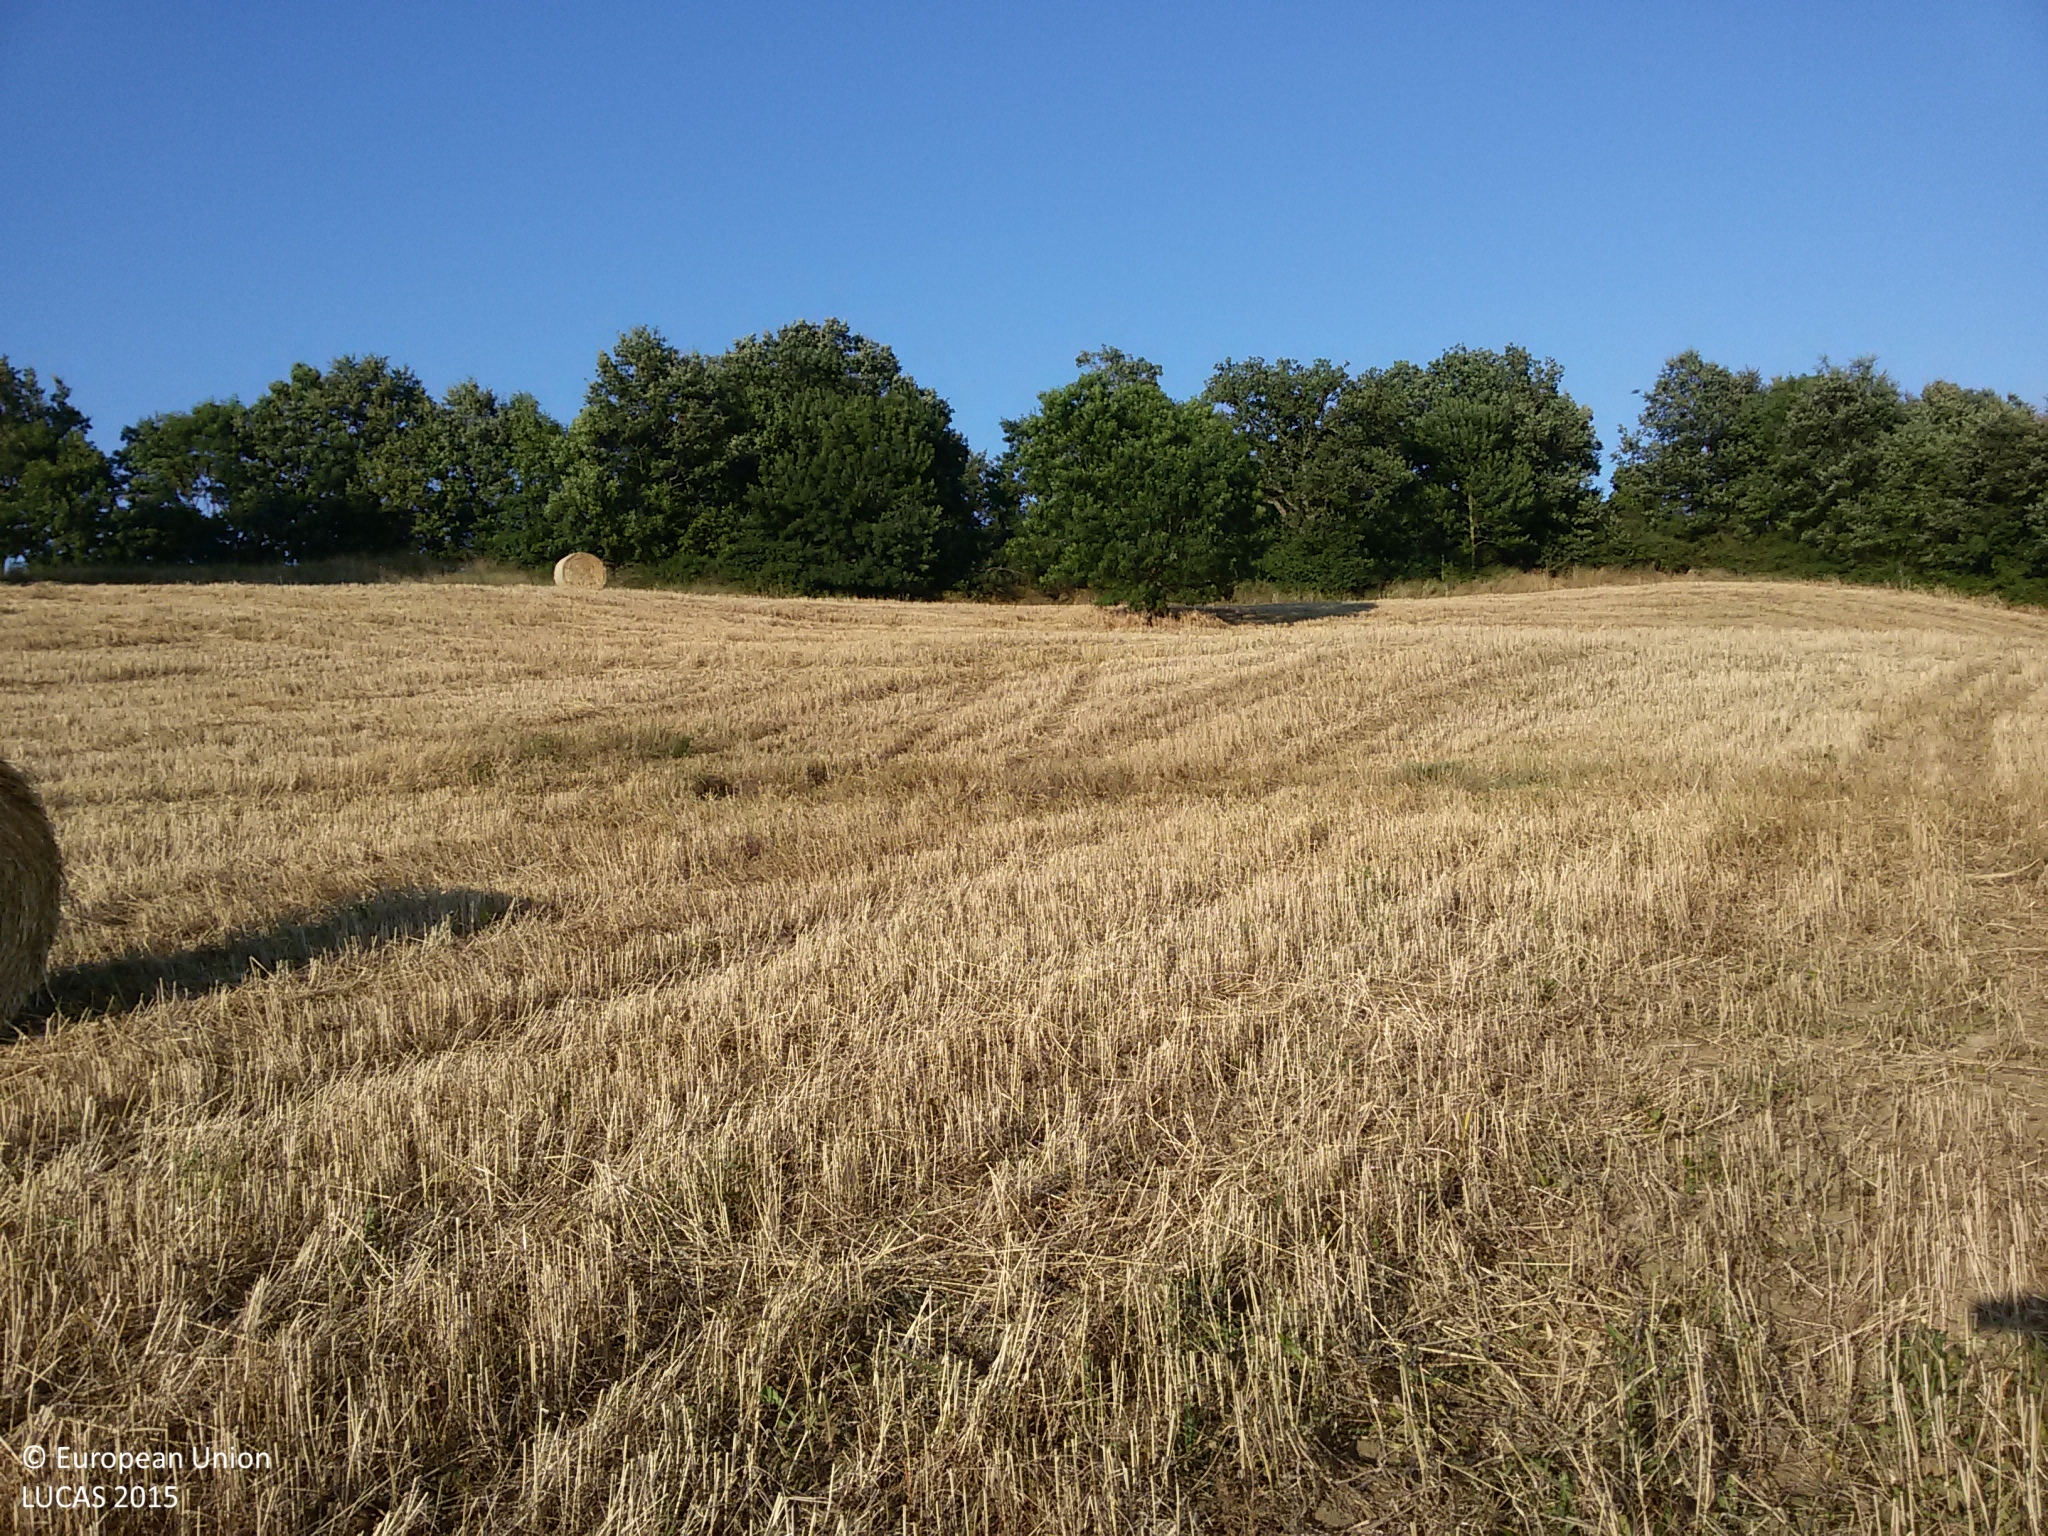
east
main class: Cropland
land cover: Durum wheat
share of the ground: > 75 %
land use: Agriculture (excluding fallow land and kitchen gardens)
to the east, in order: Durum wheat; Abandoned hedges; Tracks; Fences; Electric lines; Abandoned hedges; Grassland with sparse tree/shrub cover; Artificial constructions in urban areas; Abandoned hedges; Spontaneously vegetated surfaces; Abandoned hedges; Spontaneously vegetated surfaces; Abandoned hedges; Fences; Durum wheat
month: July
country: IT
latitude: 42.7517
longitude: 11.4735
